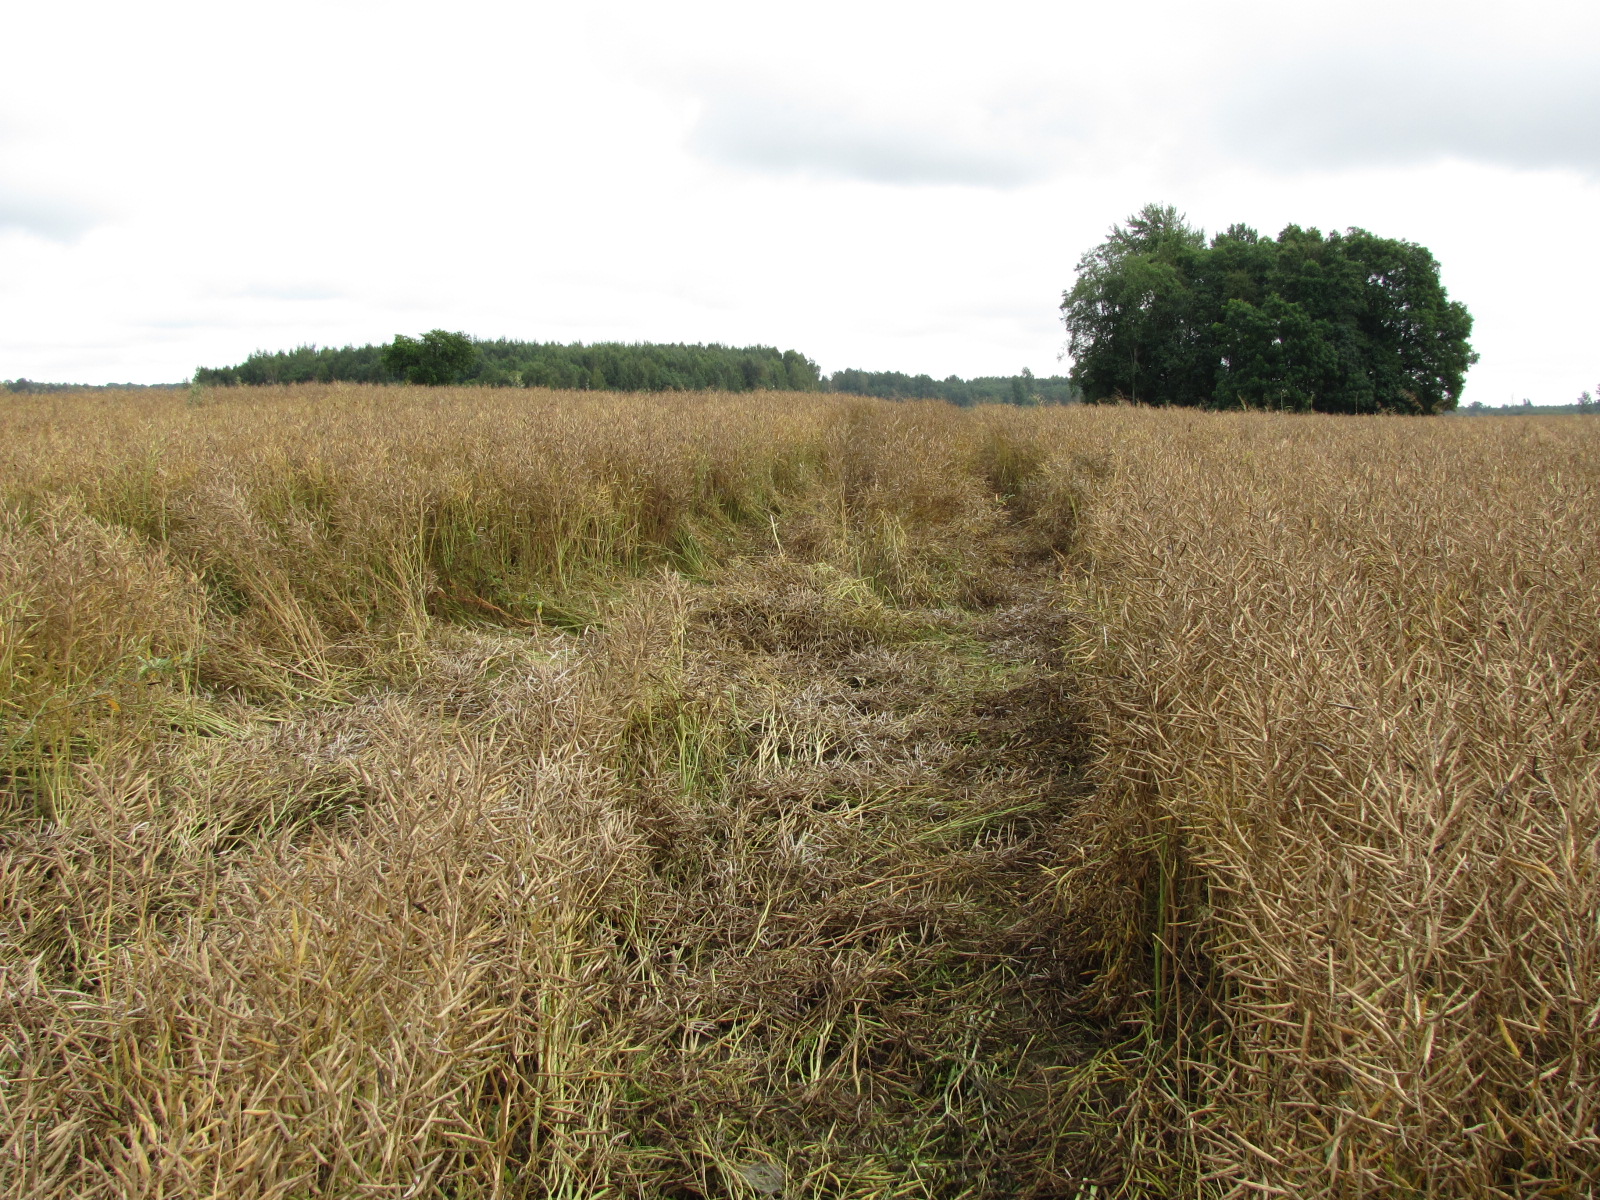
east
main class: Cropland
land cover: Rape and turnip rape
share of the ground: > 75 %
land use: Agriculture (excluding fallow land and kitchen gardens)
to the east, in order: Rape and turnip rape
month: September
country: LV
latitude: 56.6388
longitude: 25.2942
